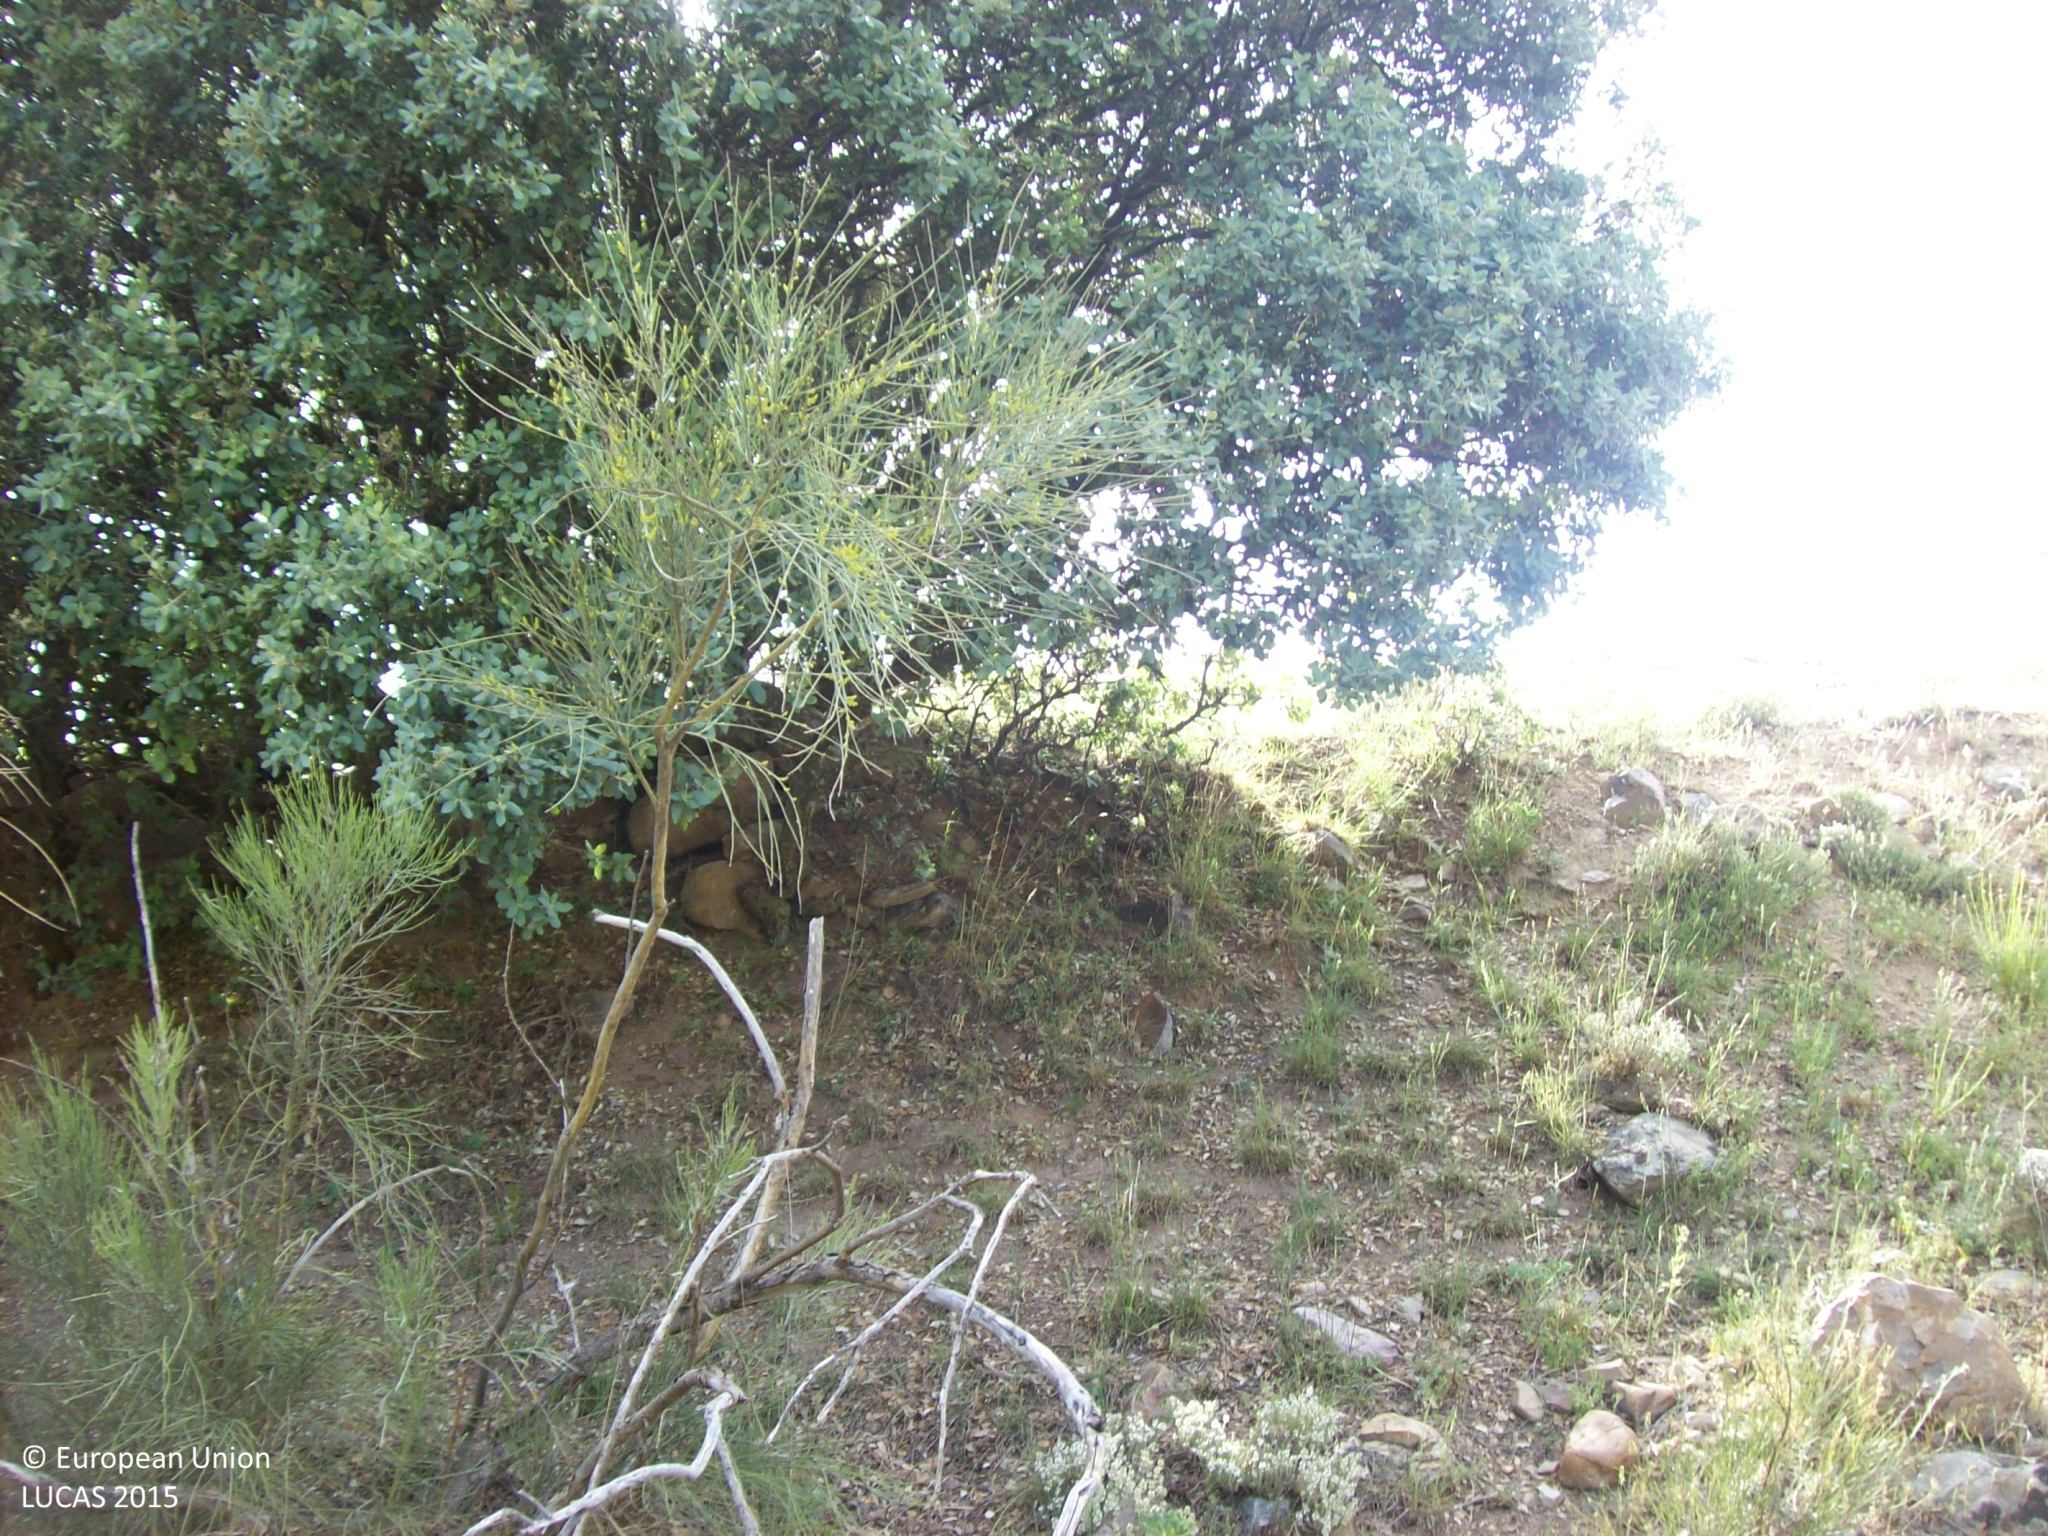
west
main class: Woodland
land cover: Broadleaved woodland
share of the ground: 10 - 25 %
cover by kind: herbaceous plants 55 %, shrubs 25 %, broadleaved forest trees 10 %, consolidated bare surface 10 %
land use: Semi-natural and natural areas not in use
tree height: < 5 m
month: May
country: ES
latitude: 40.8296
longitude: -4.5338
